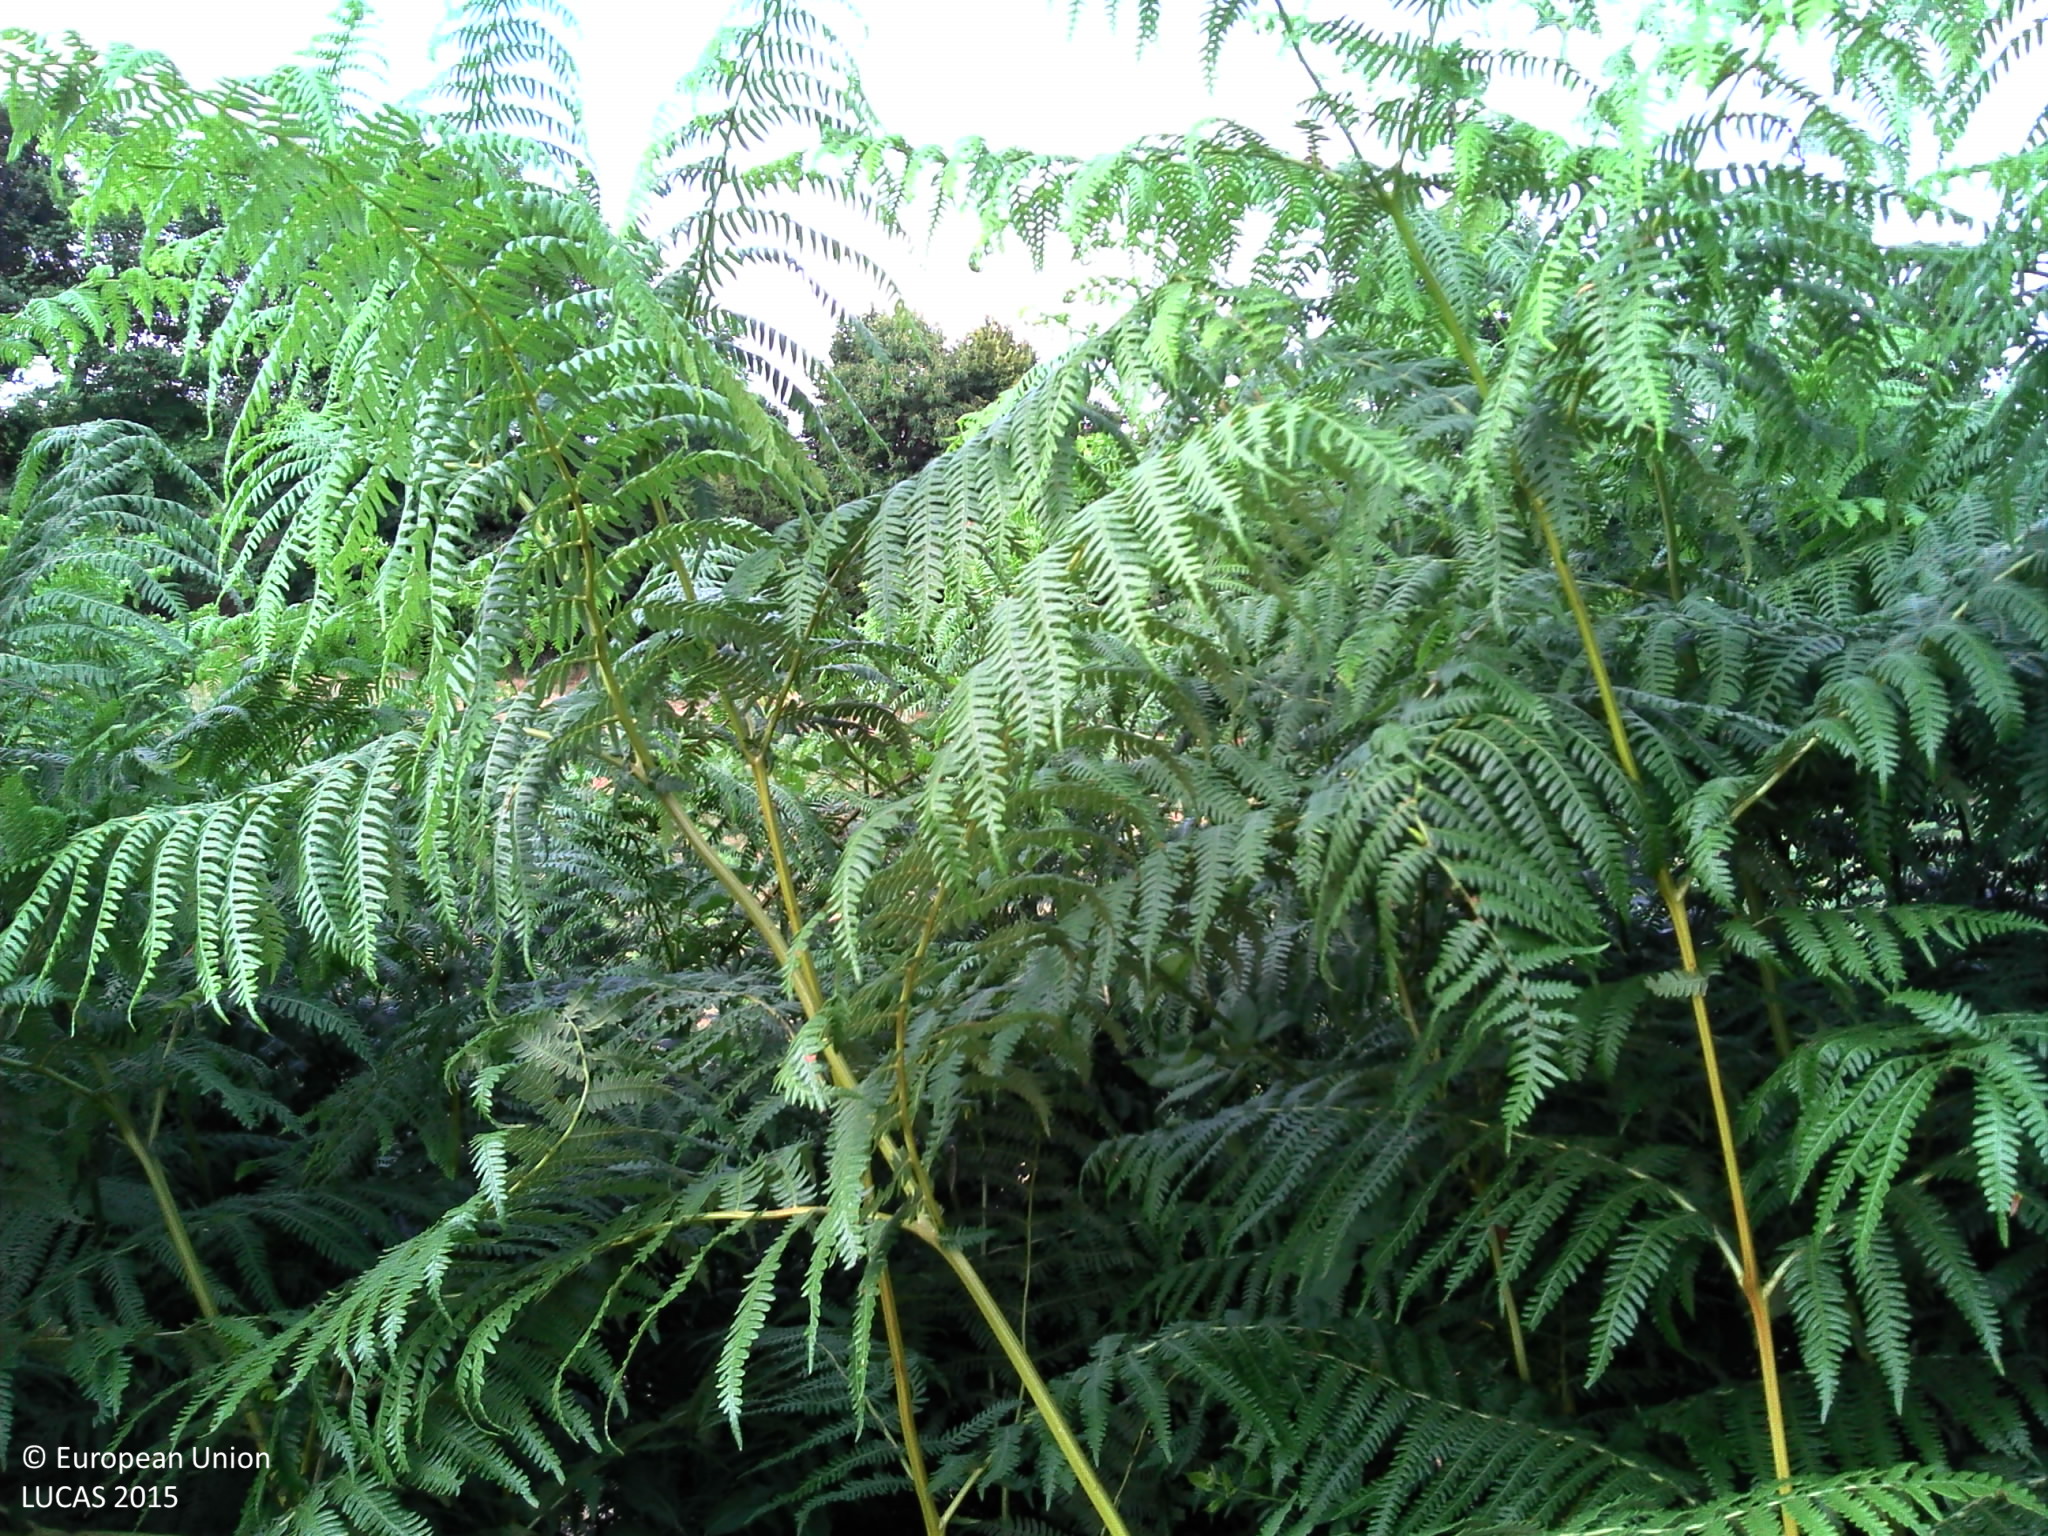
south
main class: Grassland
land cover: Grassland without tree/shrub cover
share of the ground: > 75 %
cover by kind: herbaceous plants 95 %
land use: Agriculture (excluding fallow land and kitchen gardens)
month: July
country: FR
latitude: 45.8455
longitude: 1.0141
